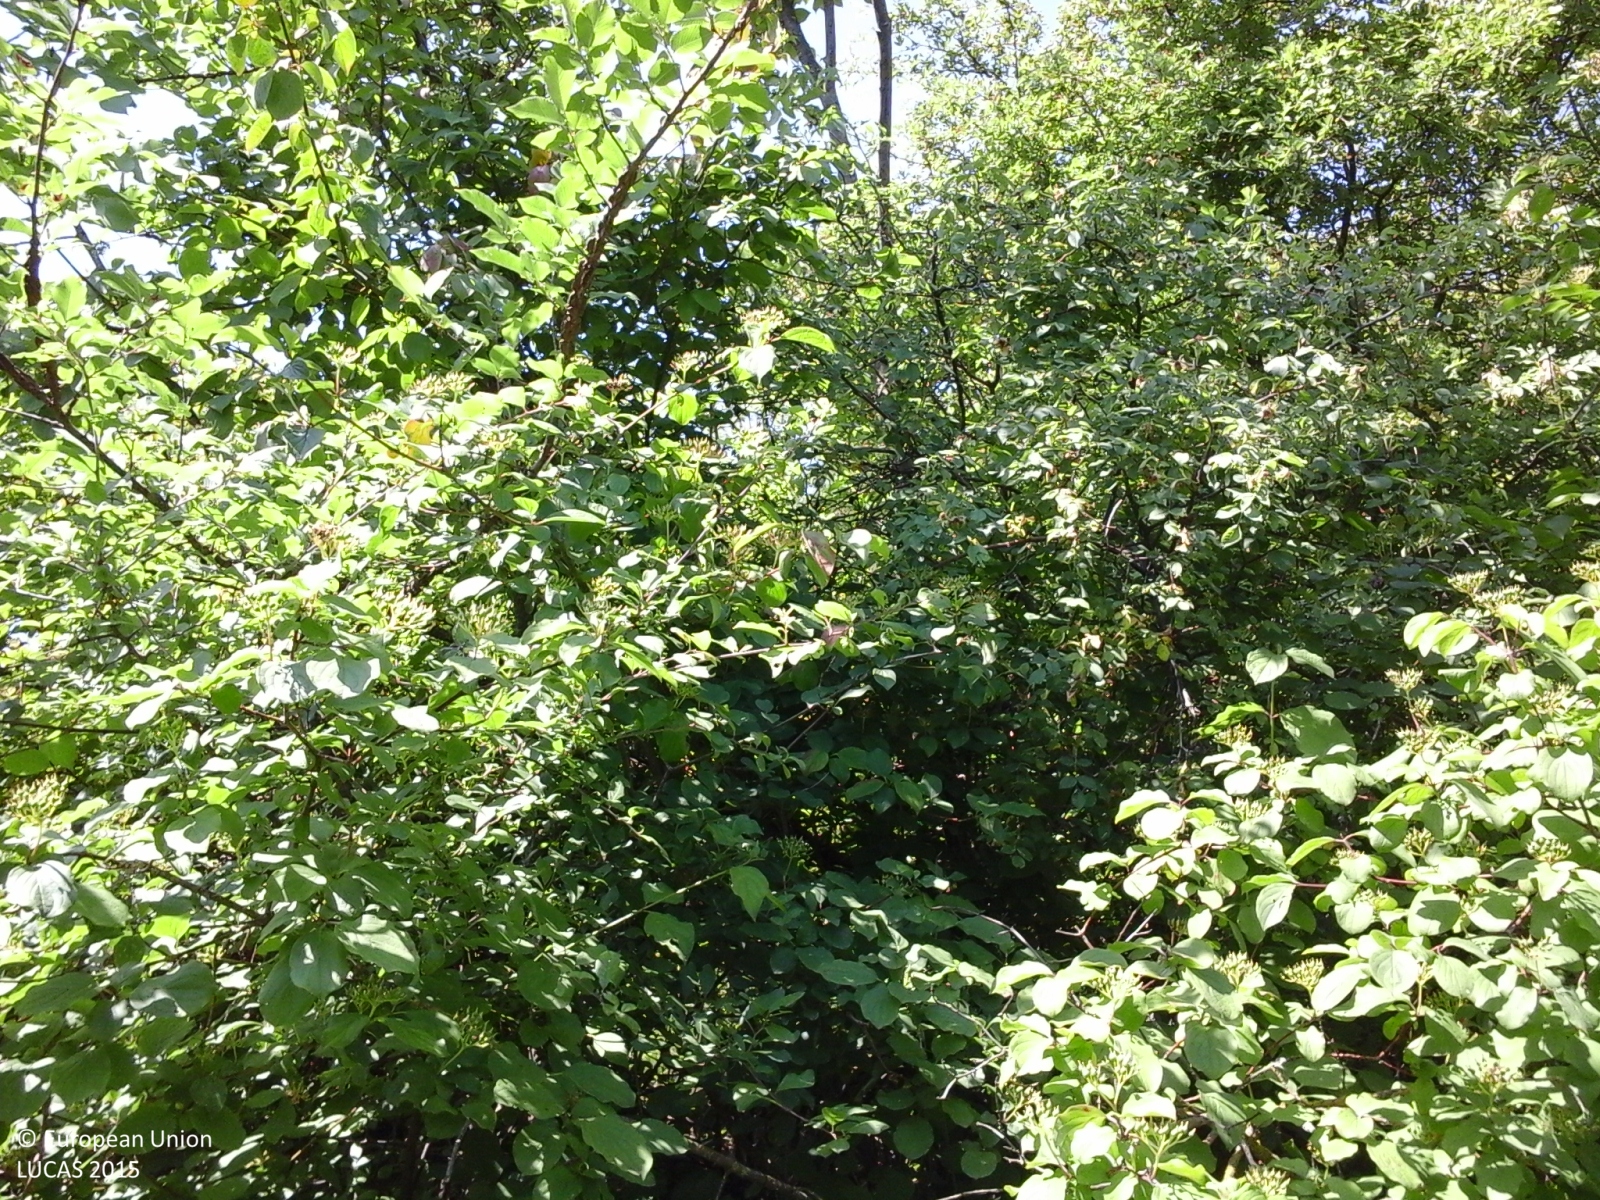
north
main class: Woodland
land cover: Broadleaved woodland
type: thermophilous deciduous forest
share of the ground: > 75 %
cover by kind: broadleaved forest trees 75 %, shrubs 25 %
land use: Forestry
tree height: > 5 m
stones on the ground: < 10 %
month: May
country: IT
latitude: 44.7653
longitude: 10.0630
